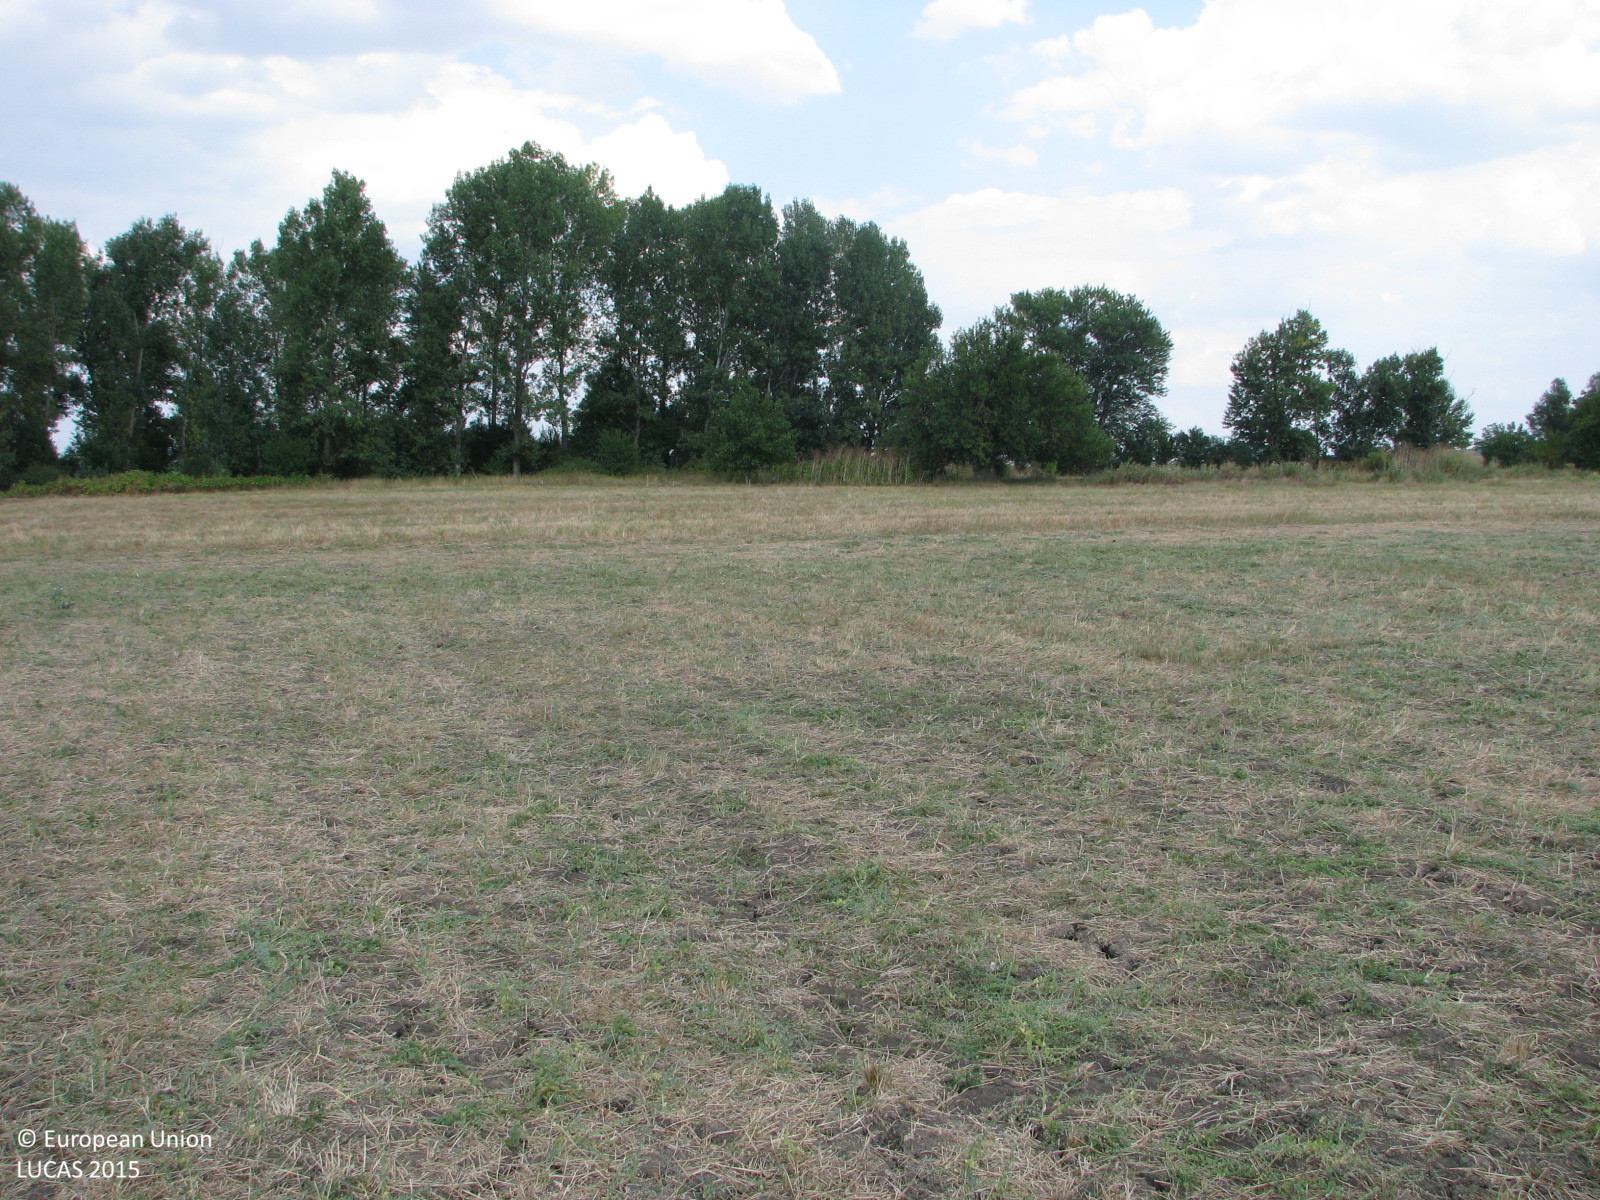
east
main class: Cropland
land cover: Common wheat
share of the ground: 25 - 50 %
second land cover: Spontaneously vegetated surfaces
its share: 25 - 50 %
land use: Agriculture (excluding fallow land and kitchen gardens)
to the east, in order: Common wheat; Spontaneously vegetated surfaces; Grassland with sparse tree/shrub cover; Broadleaved woodland; Ditches and canals; Grassland without tree/shrub cover
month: August
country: BG
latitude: 42.1266
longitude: 26.7755
